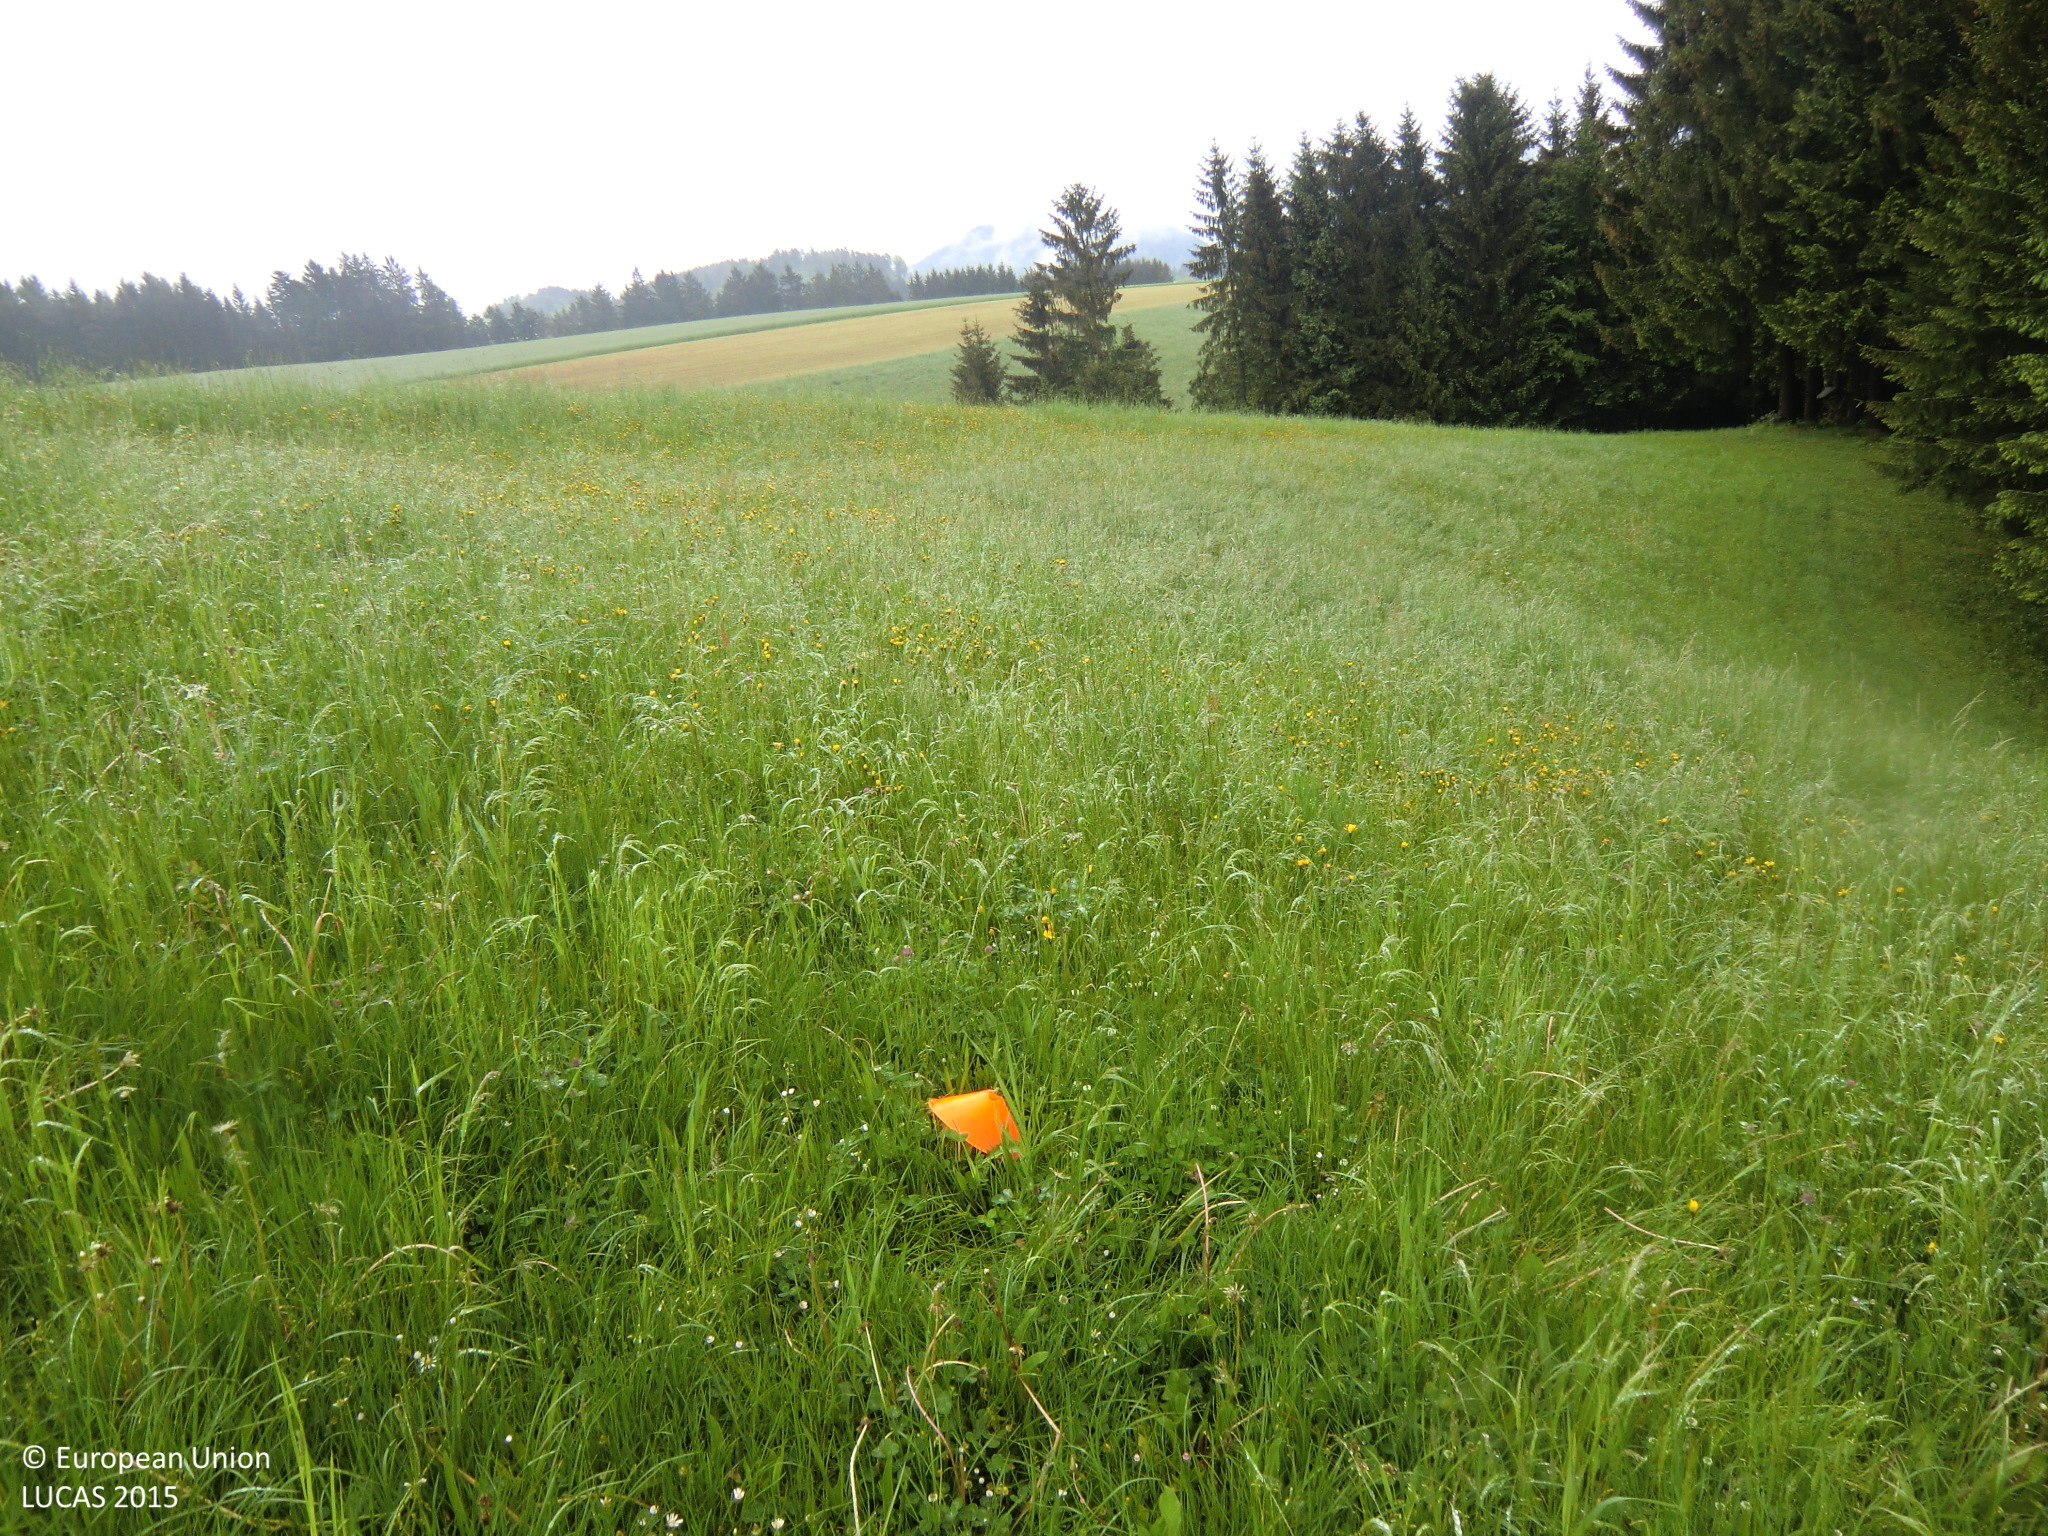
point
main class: Grassland
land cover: Grassland without tree/shrub cover
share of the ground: > 75 %
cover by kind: herbaceous plants 100 %
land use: Agriculture (excluding fallow land and kitchen gardens)
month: May
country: AT
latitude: 48.3752
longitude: 14.7126
